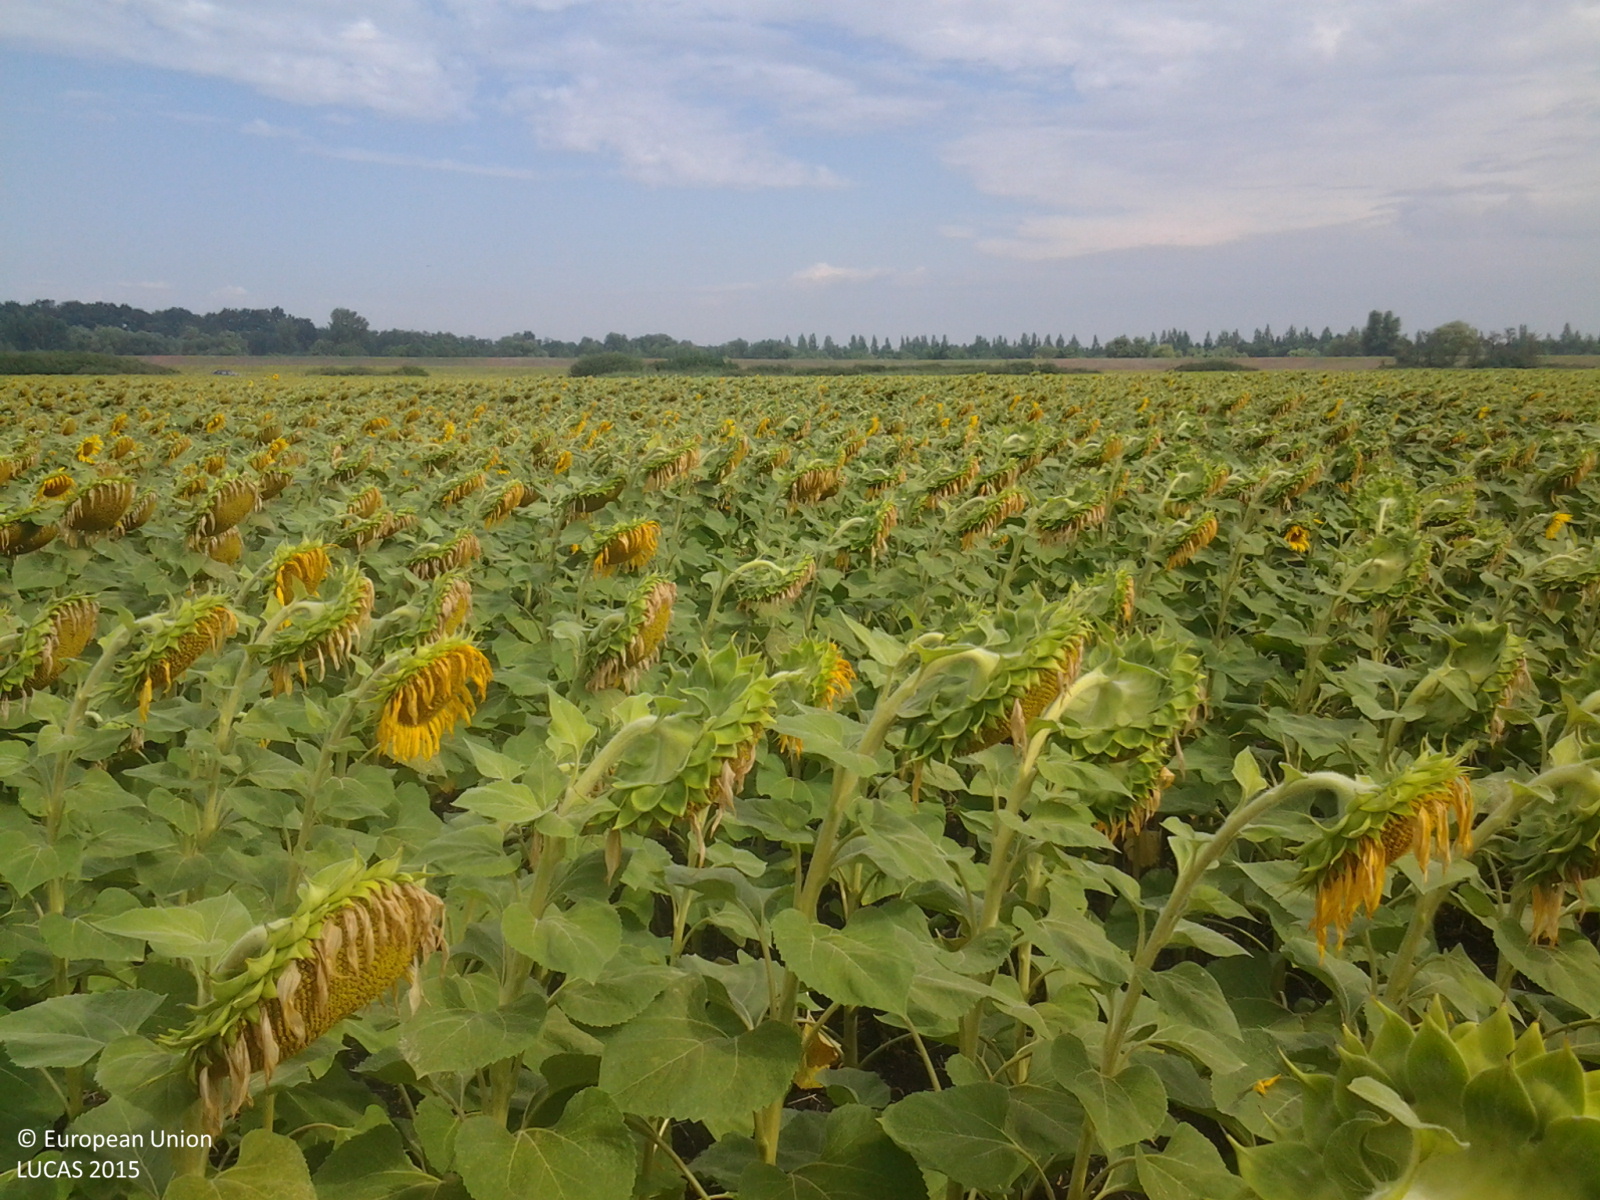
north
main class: Cropland
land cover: Sunflower
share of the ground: > 75 %
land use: Agriculture (excluding fallow land and kitchen gardens)
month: August
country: HU
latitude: 46.9762
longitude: 21.2235
